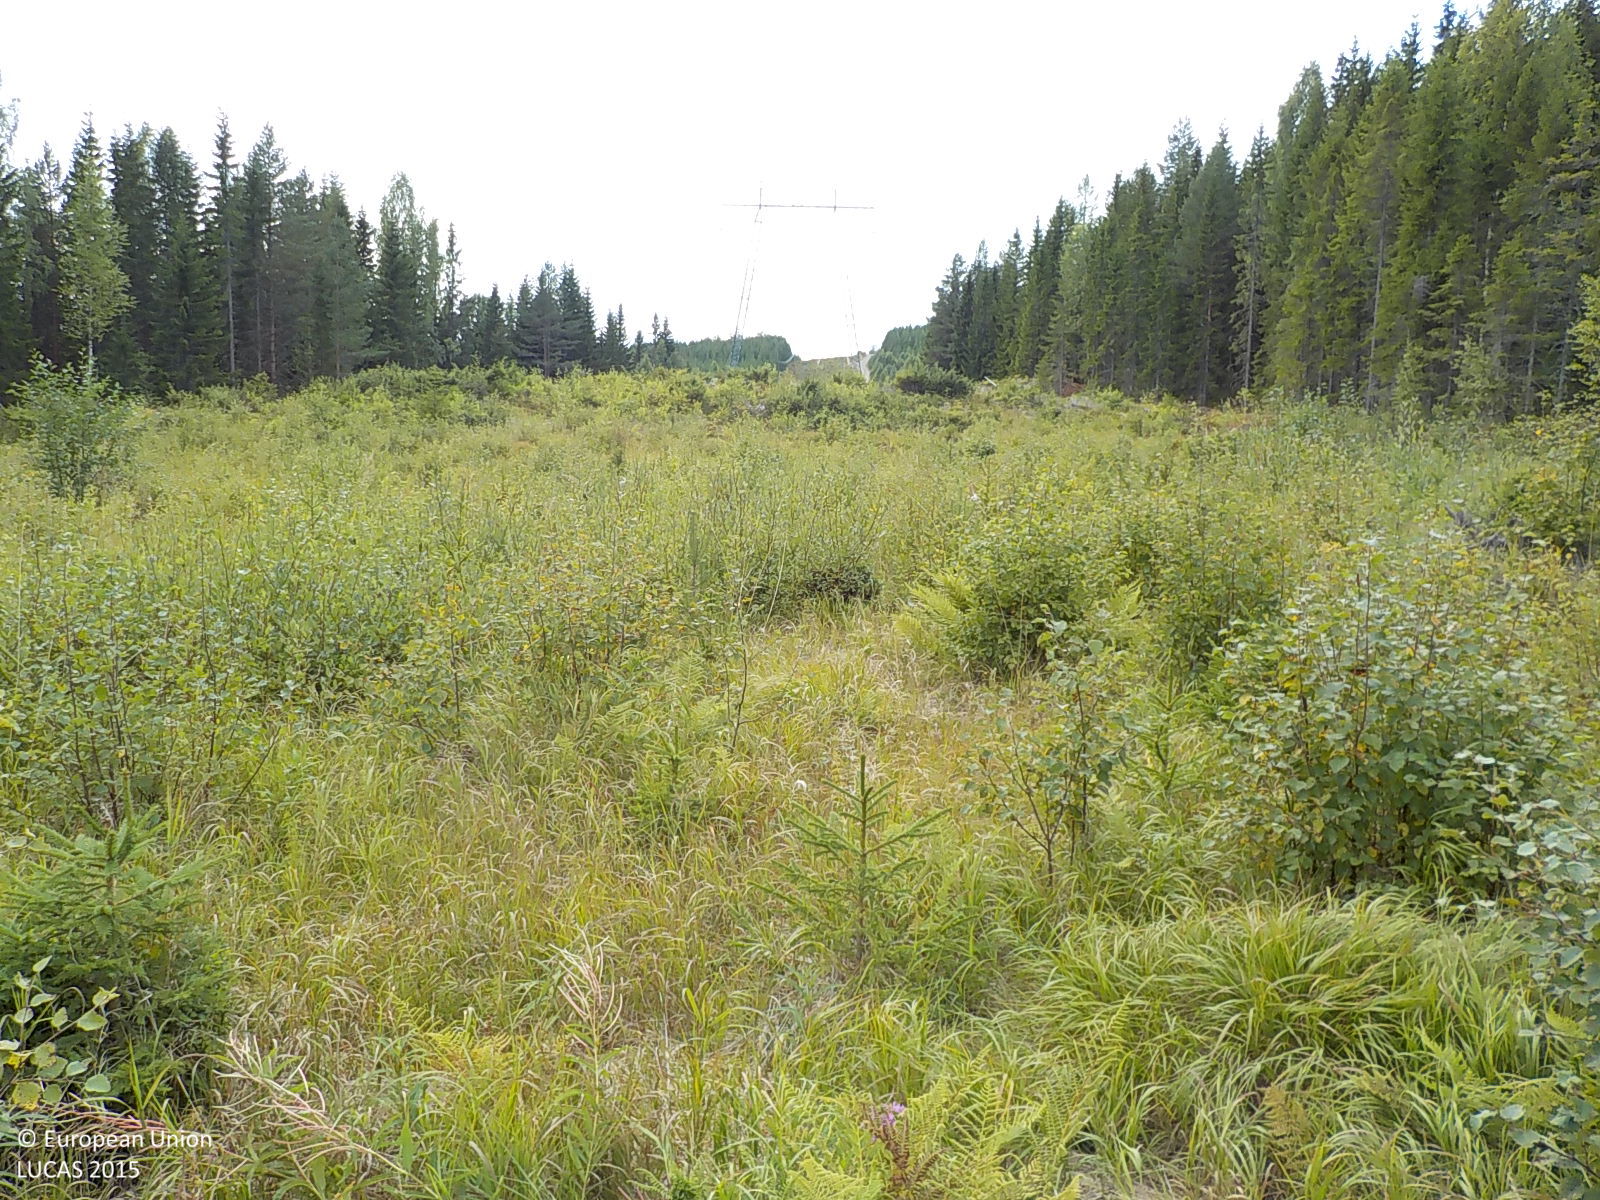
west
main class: Artificial land
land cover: Other artificial areas
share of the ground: 50 - 75 %
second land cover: Broadleaved woodland
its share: 25 - 50 %
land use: Electricity, gas and thermal power distribution
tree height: < 5 m
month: September
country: SE
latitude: 63.2841
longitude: 17.7314
